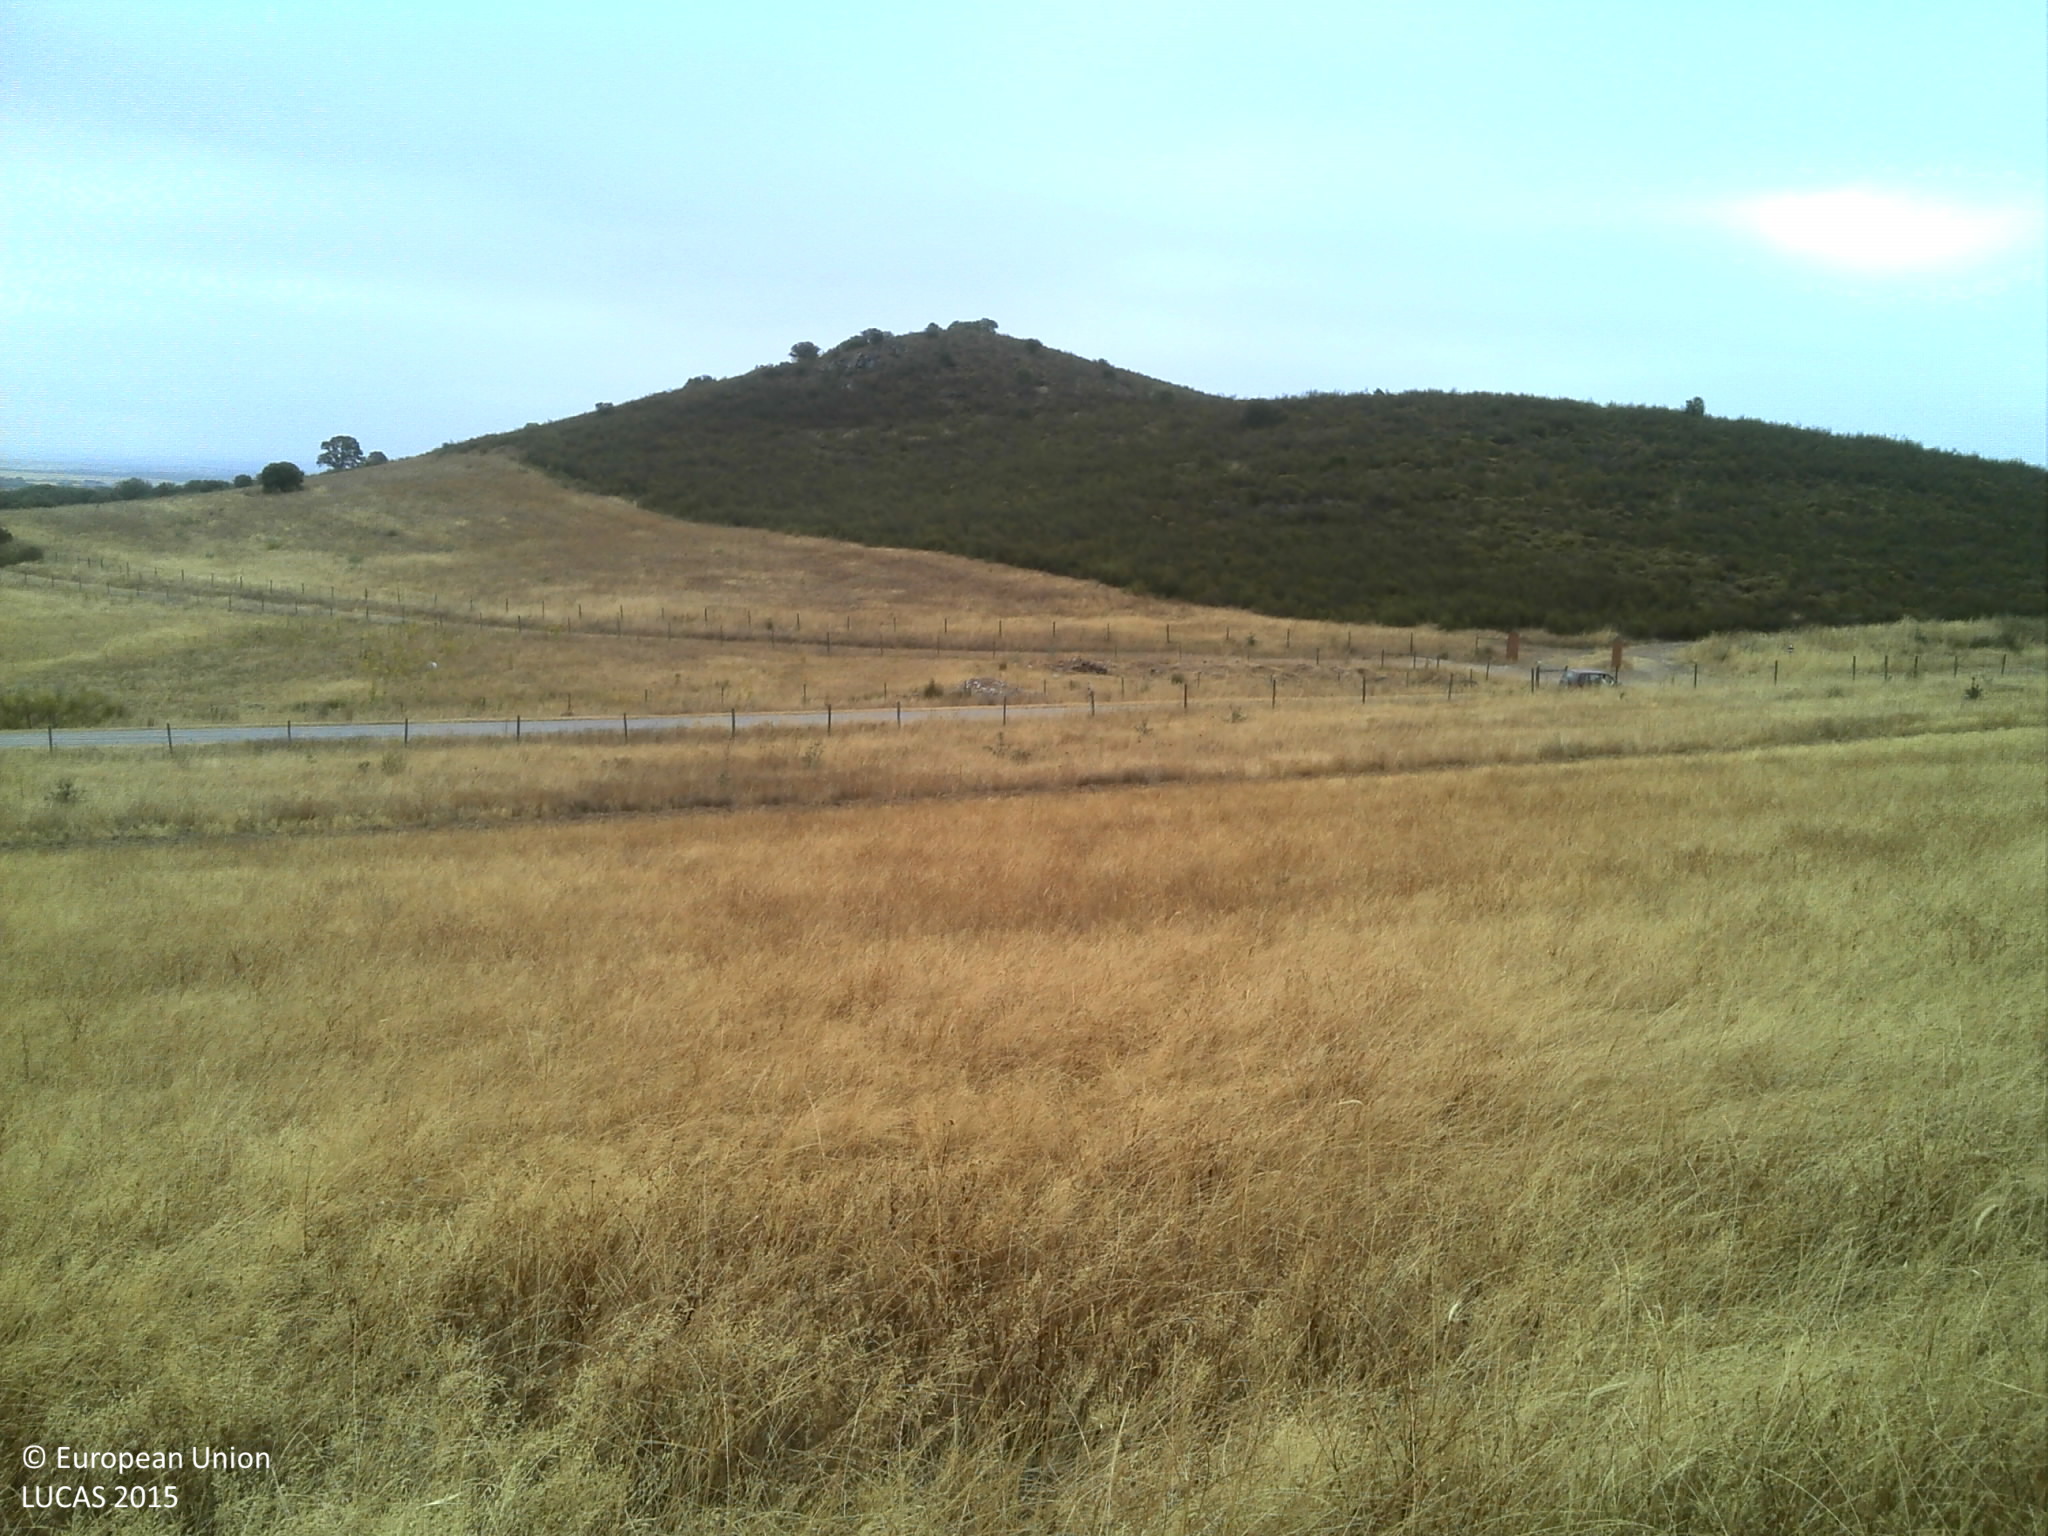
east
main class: Grassland
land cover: Grassland without tree/shrub cover
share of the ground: > 75 %
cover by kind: herbaceous plants 80 %, unconsolidated bare surface 20 %
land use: Agriculture (excluding fallow land and kitchen gardens)
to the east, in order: Grassland without tree/shrub cover; Tracks; Grassland without tree/shrub cover; Fences; Grassland without tree/shrub cover; Ditches and canals; Grass margins; Paved roads, cycling and walking lanes; Grass margins; Fences; Grassland without tree/shrub cover; Rocks and stones; Grassland without tree/shrub cover; Fences; Shruby margins; Tracks; Shruby margins; Fences; Grassland without tree/shrub cover; Shrubland without tree cover
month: July
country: PT
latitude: 38.4747
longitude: -7.4146
